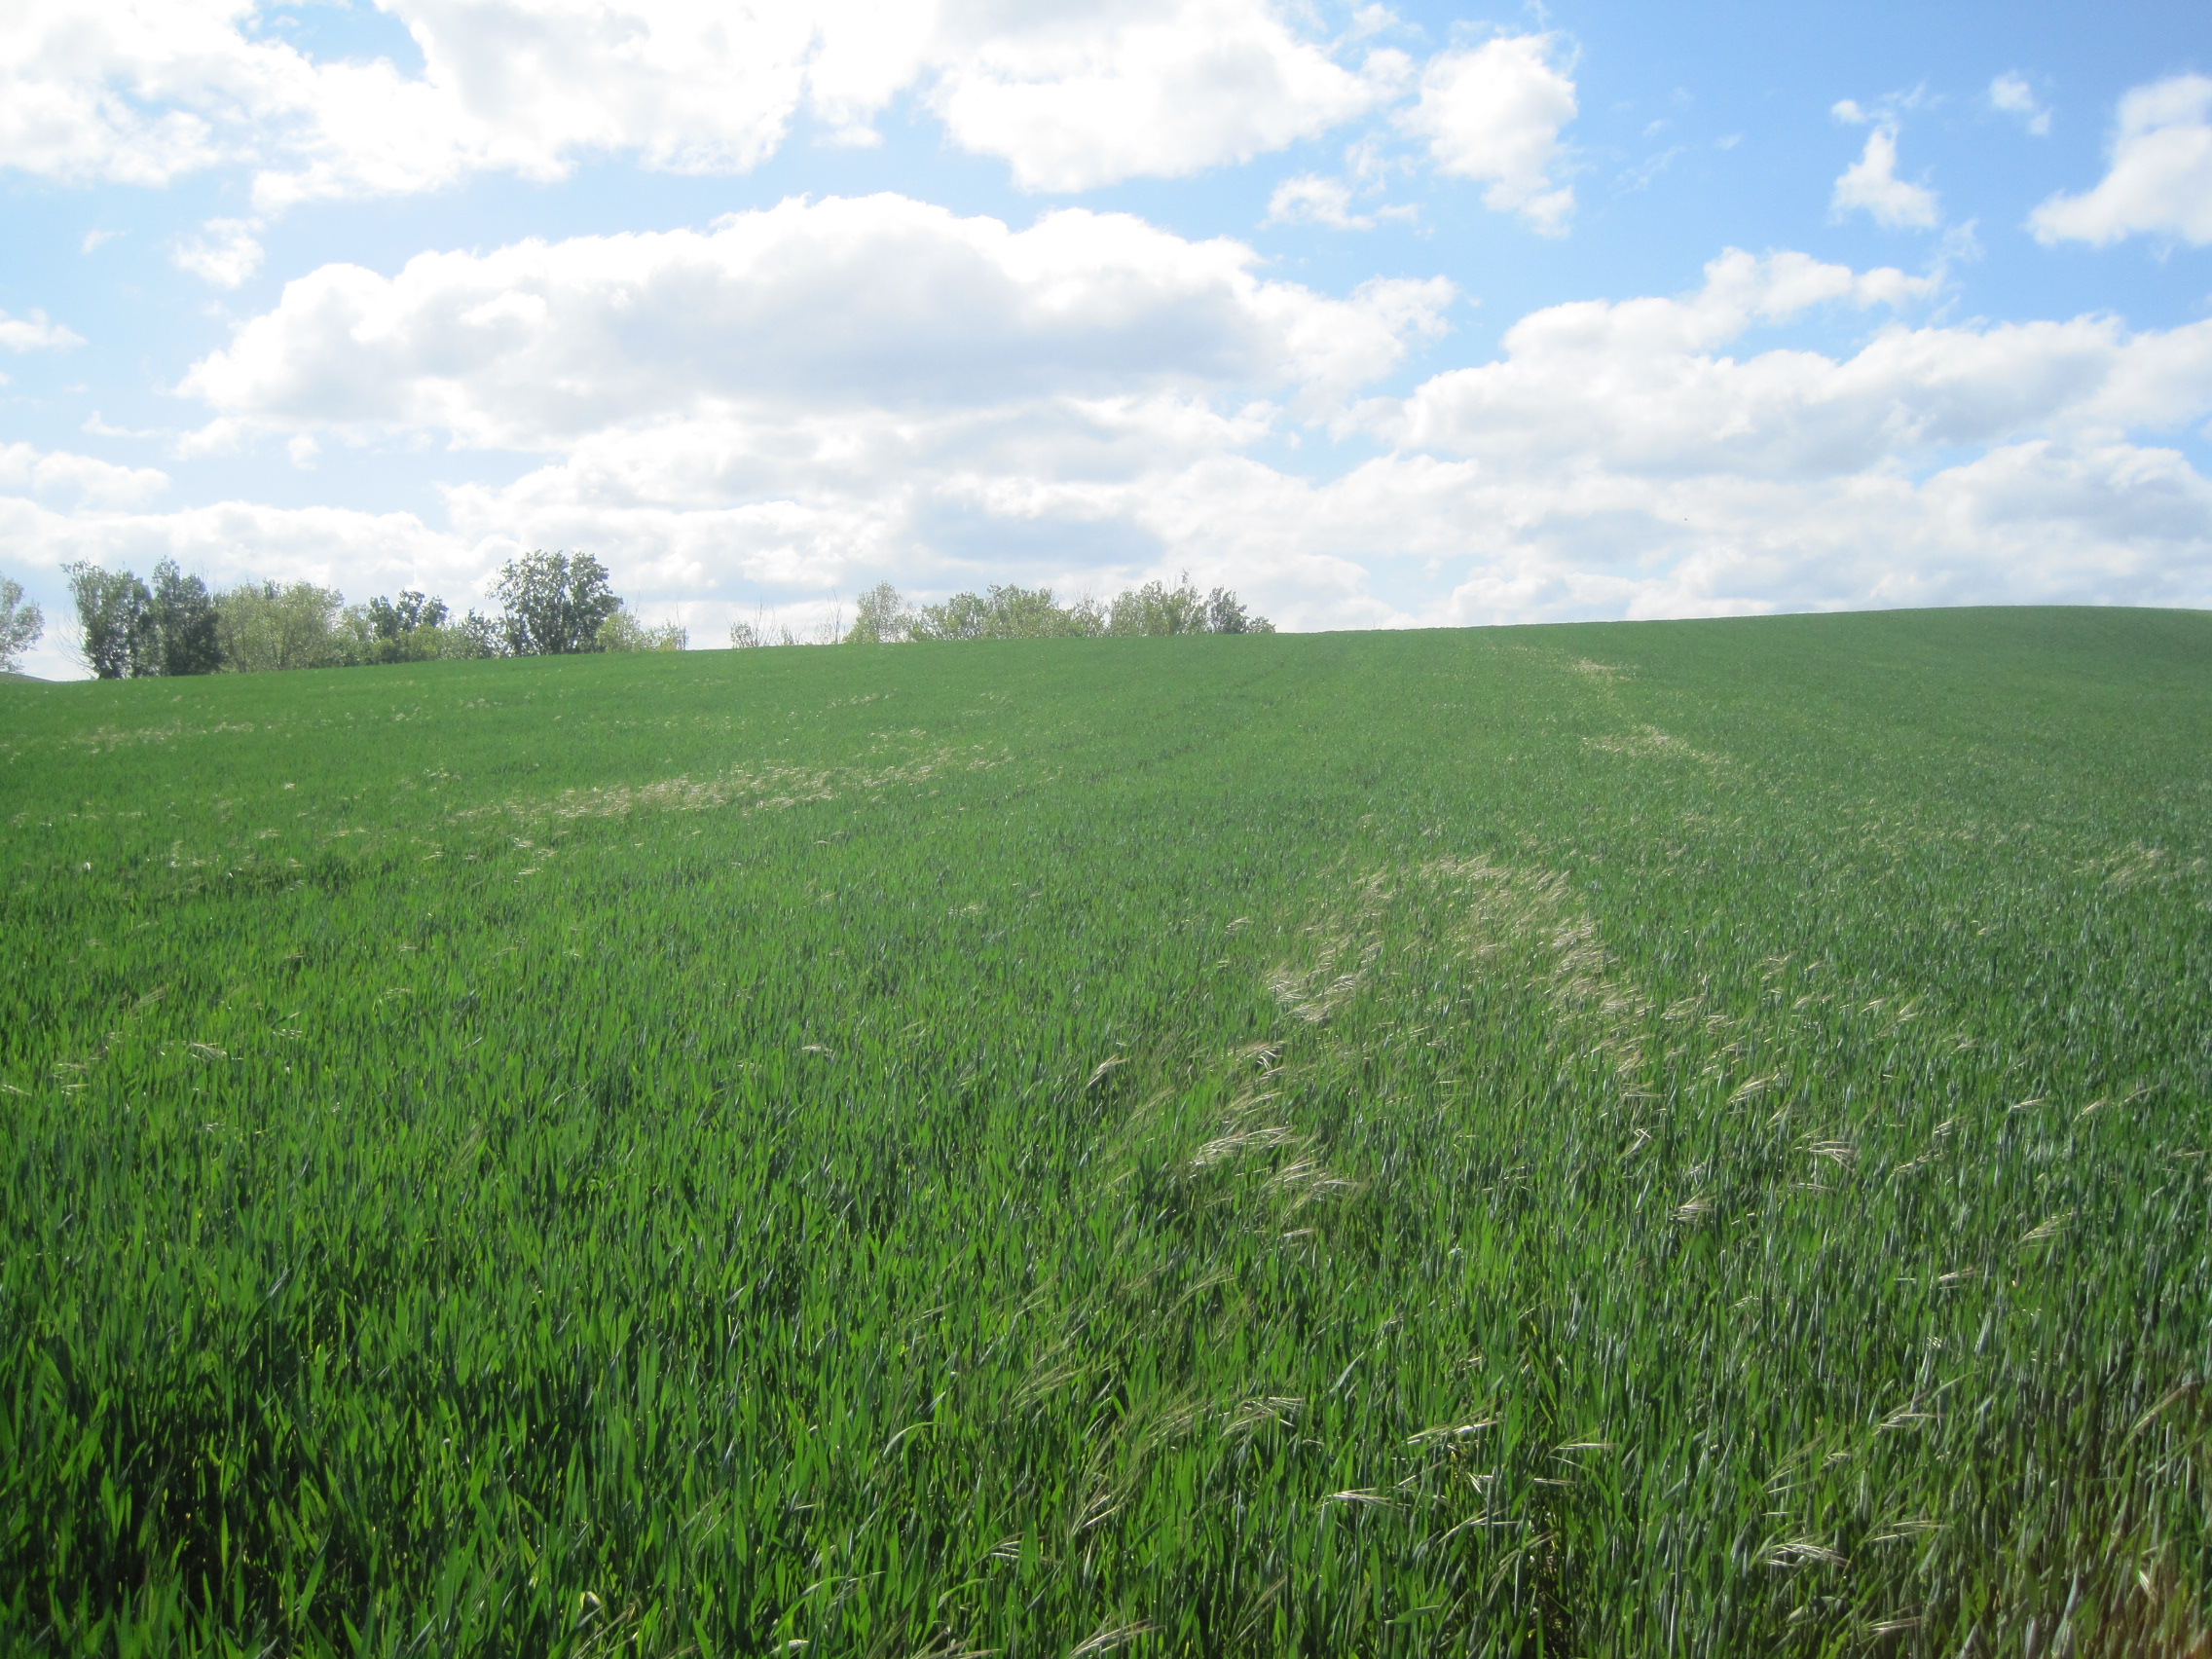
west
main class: Cropland
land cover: Common wheat
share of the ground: > 75 %
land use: Agriculture (excluding fallow land and kitchen gardens)
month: May
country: ES
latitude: 41.6367
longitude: -4.6534
